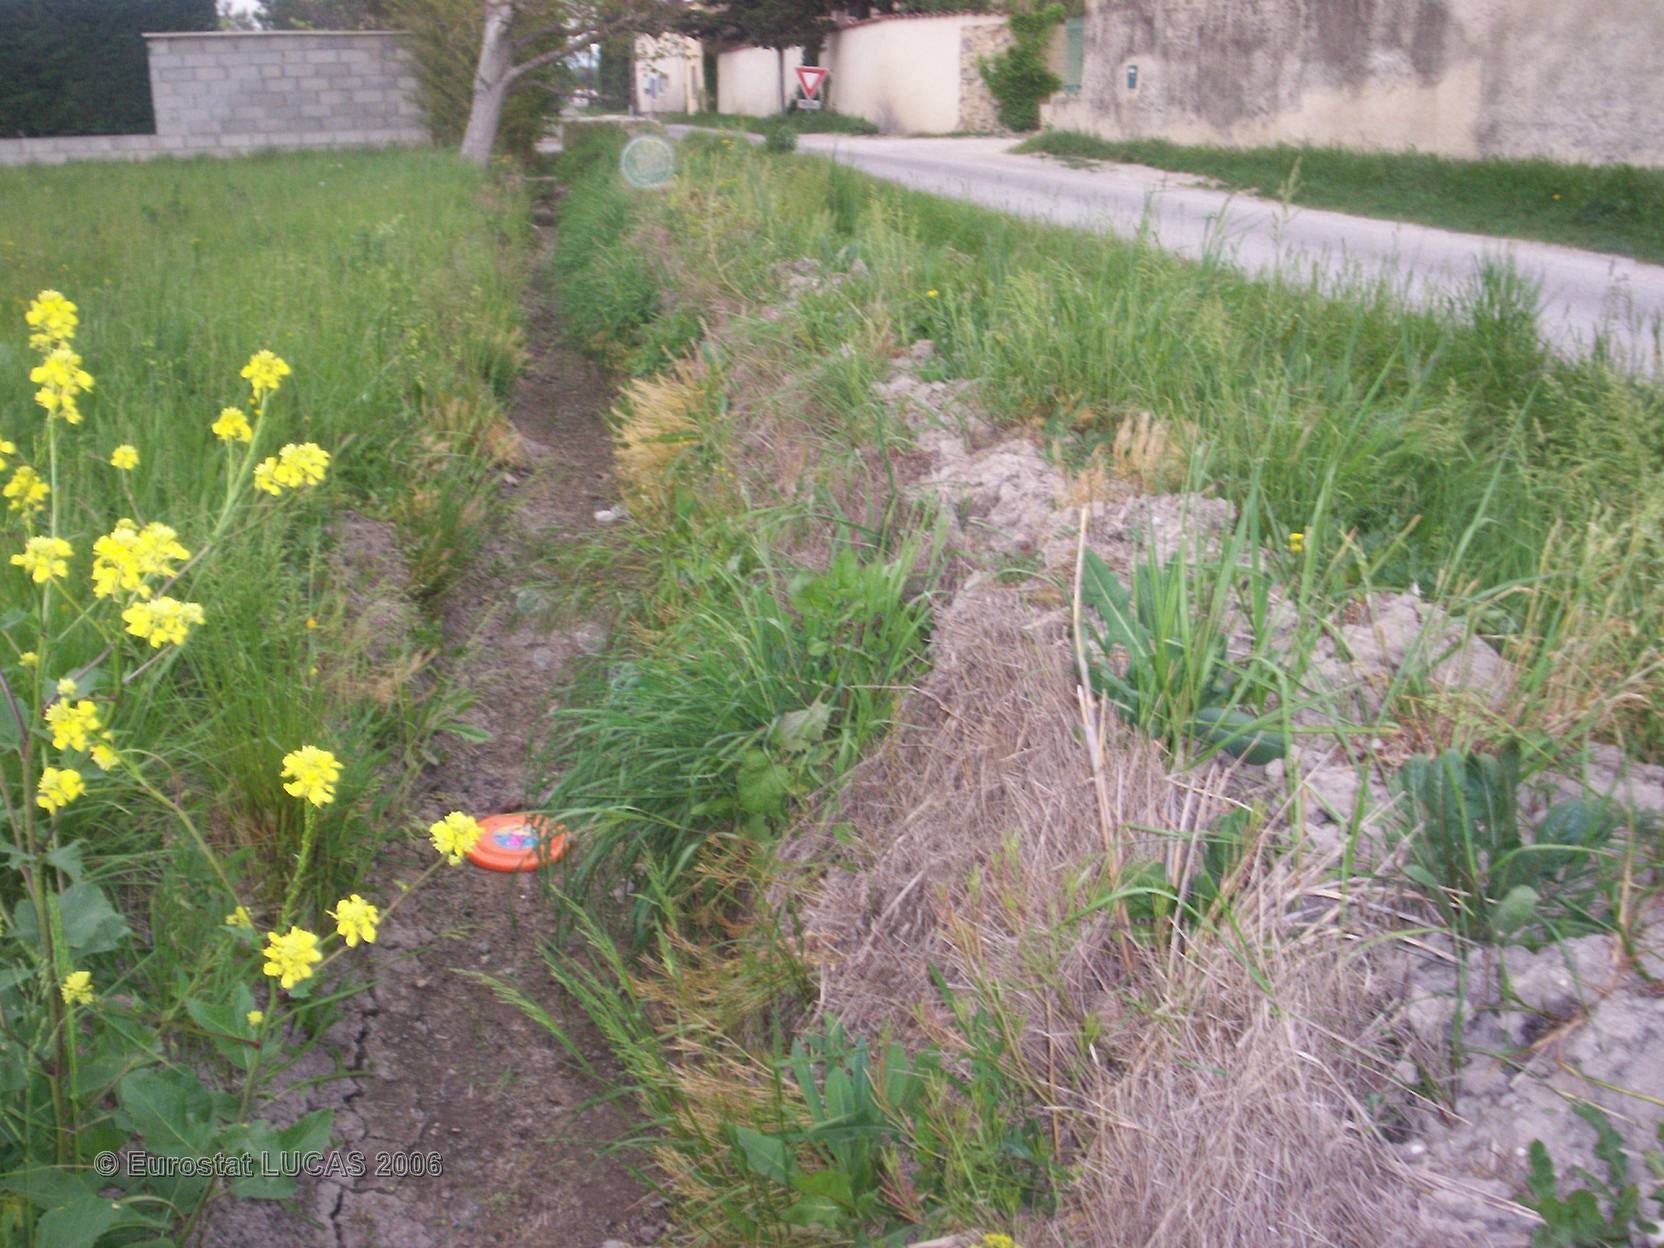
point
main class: Grassland
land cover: Grassland without tree/shrub cover
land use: Agriculture (excluding fallow land and kitchen gardens)
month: April
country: FR
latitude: 44.0483
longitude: 4.9784
